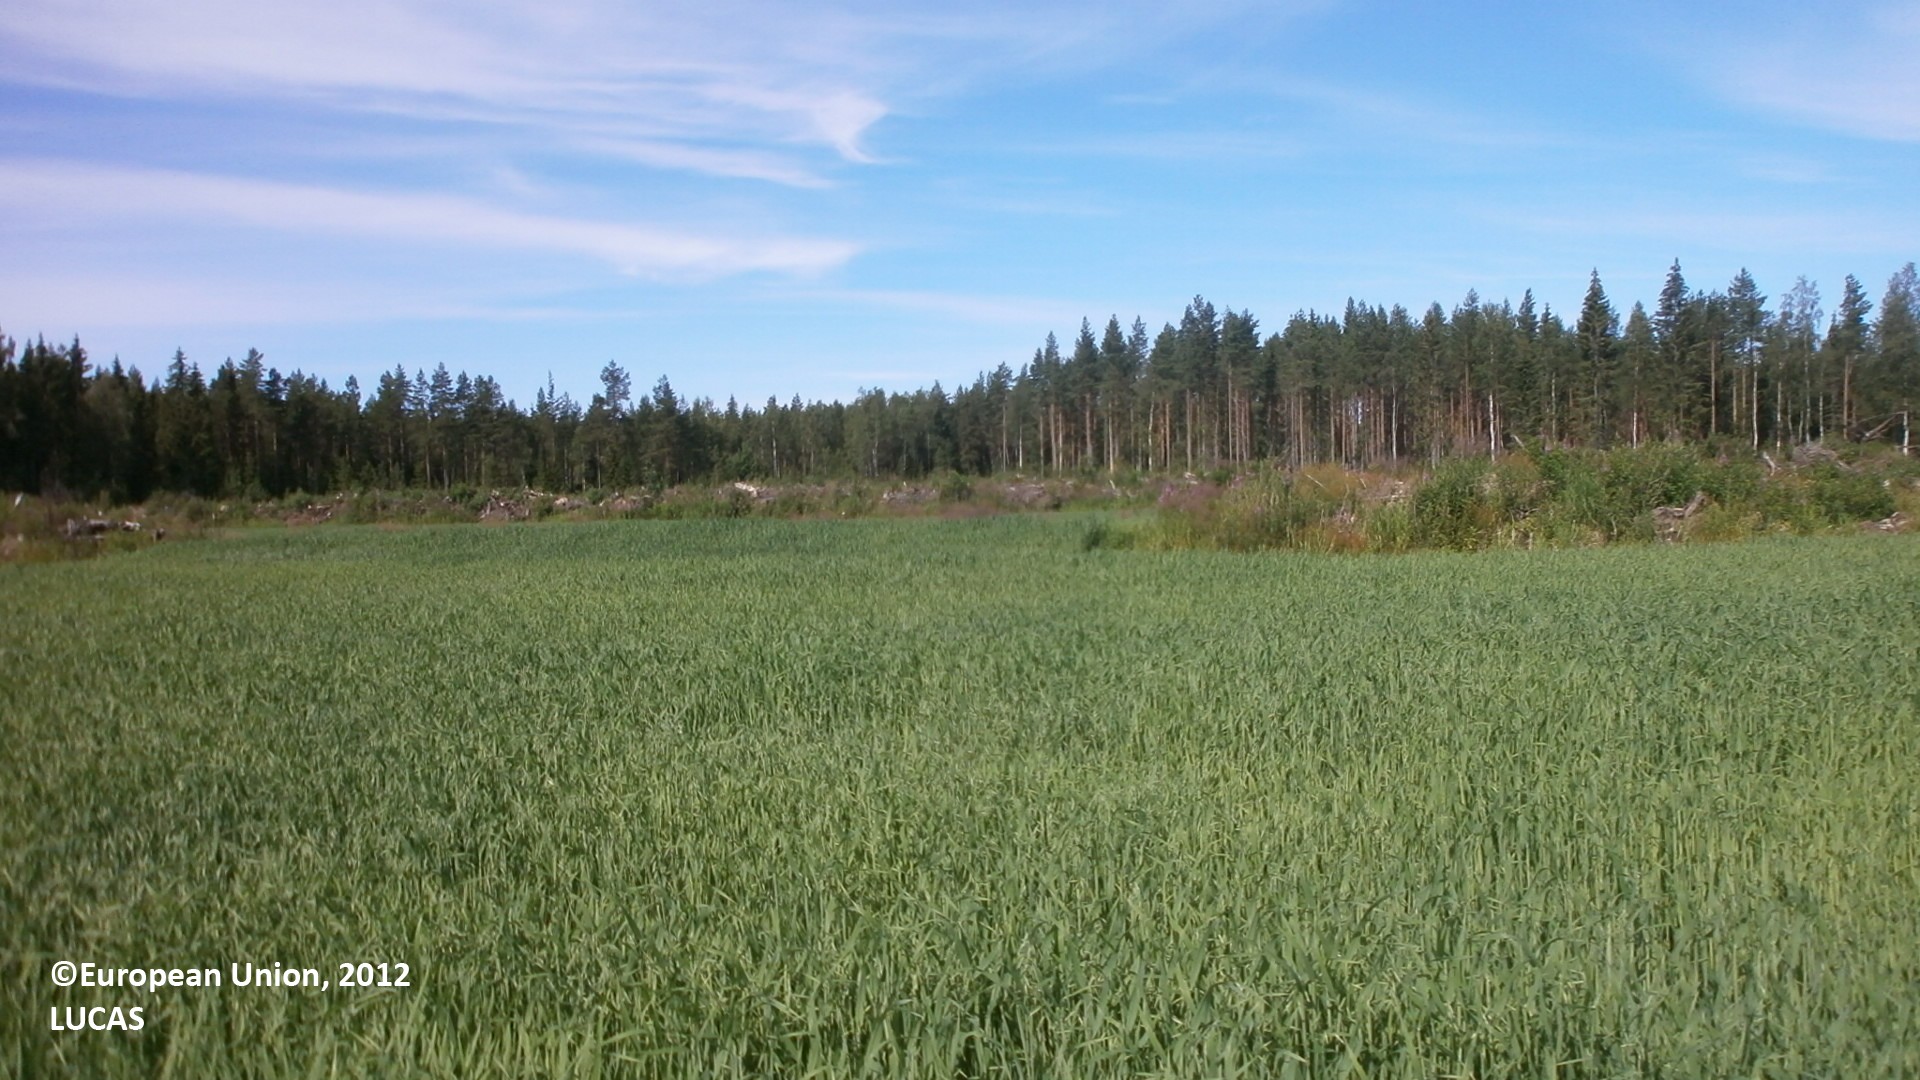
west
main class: Cropland
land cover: Oats
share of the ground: > 75 %
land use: Agriculture (excluding fallow land and kitchen gardens)
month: July
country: FI
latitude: 64.4007
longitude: 24.1907
